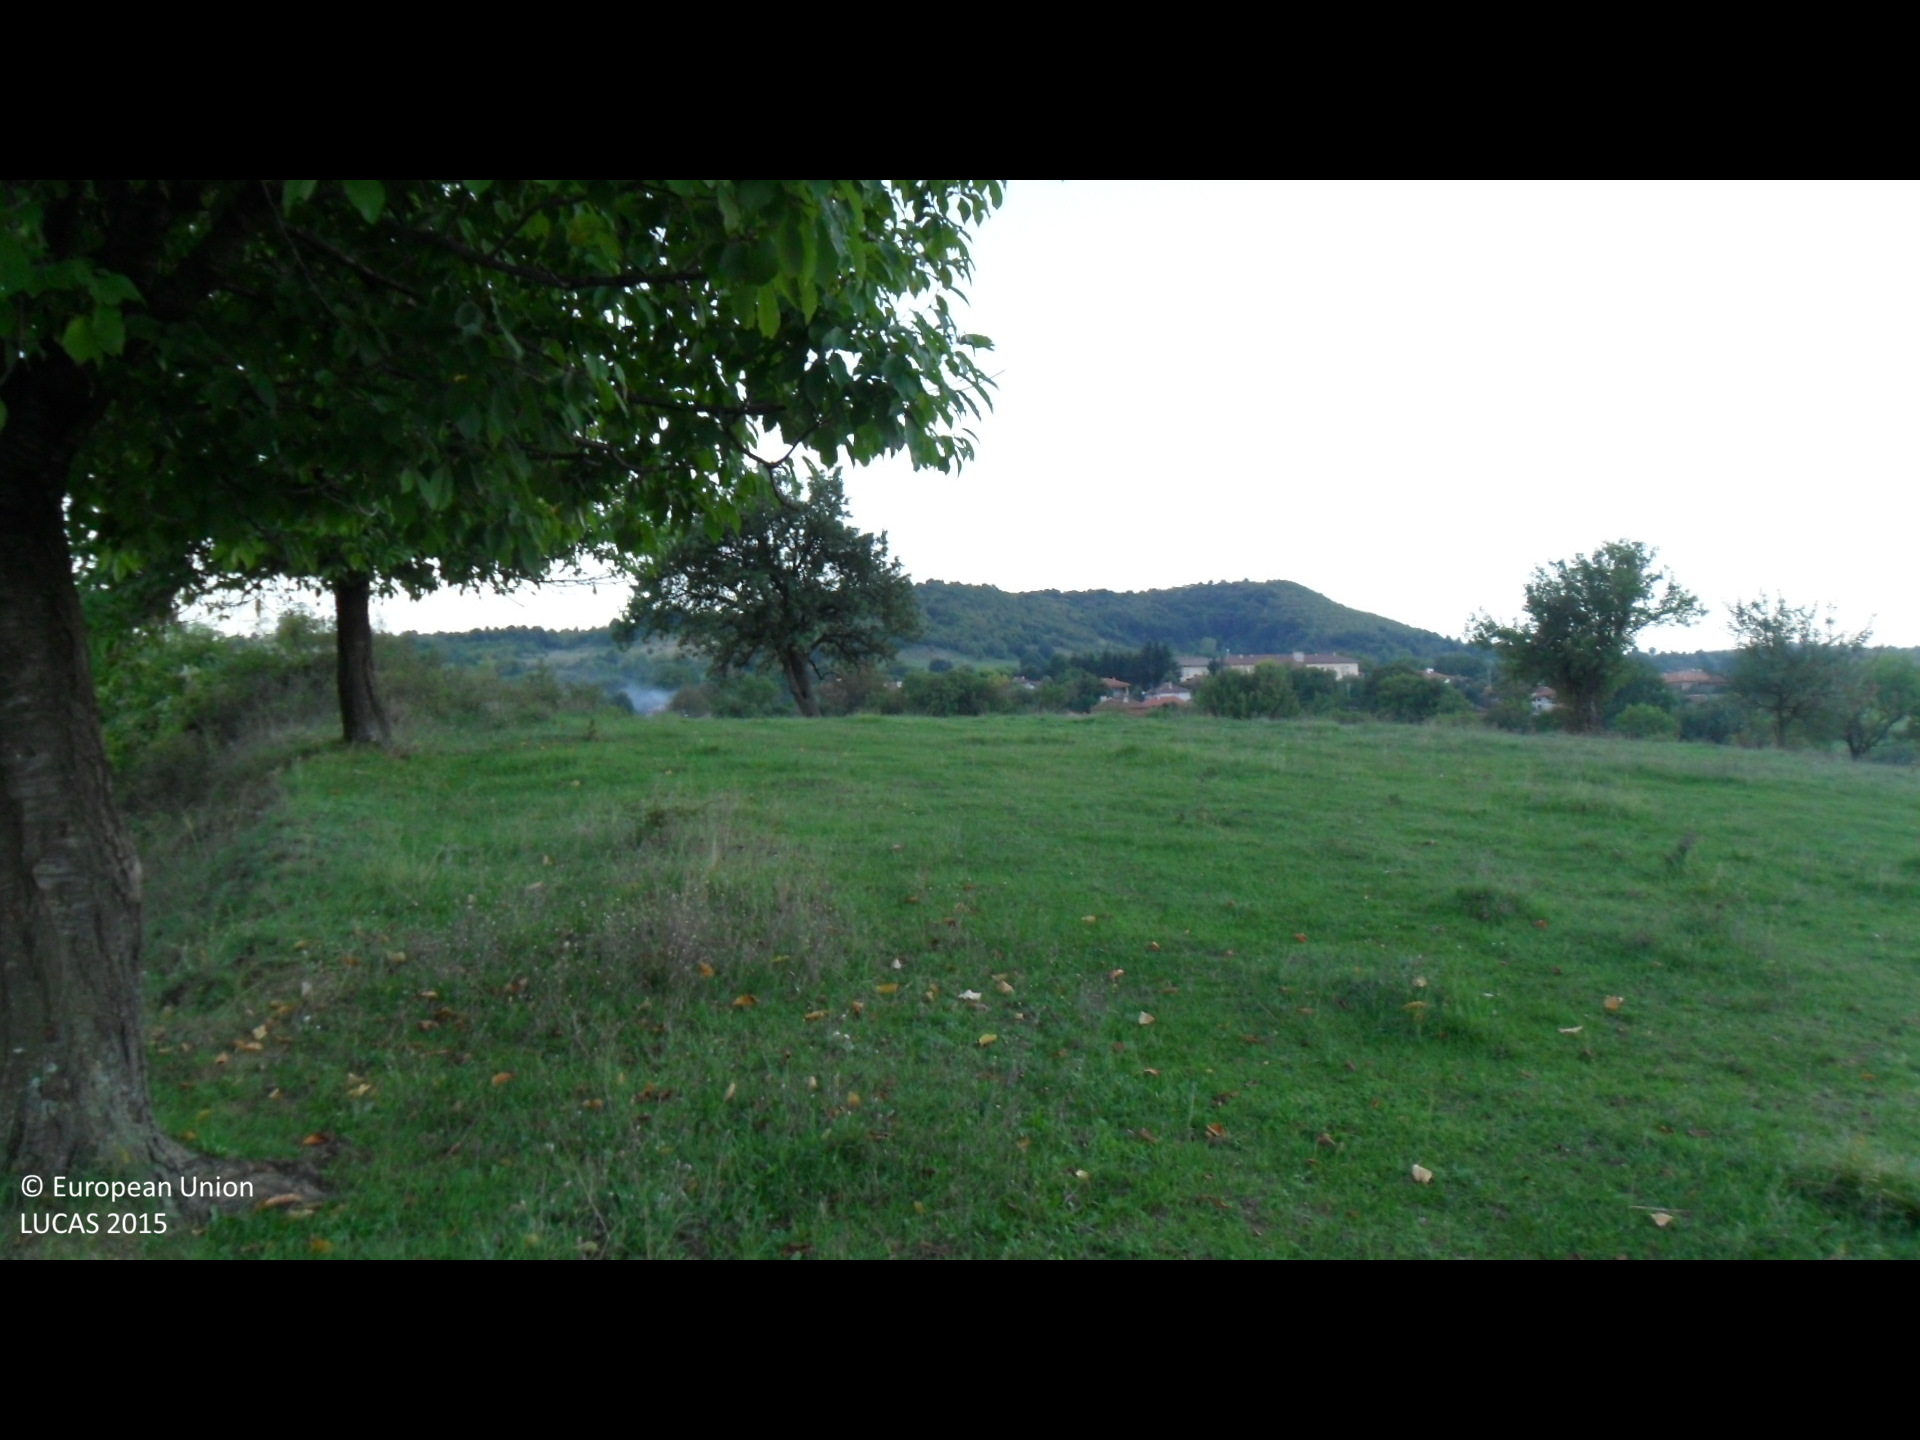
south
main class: Grassland
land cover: Grassland with sparse tree/shrub cover
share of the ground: > 75 %
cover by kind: herbaceous plants 90 %, broadleaved forest trees 5 %, shrubs 5 %
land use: Agriculture (excluding fallow land and kitchen gardens)
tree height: < 5 m
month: September
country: BG
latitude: 42.9828
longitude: 26.4943
